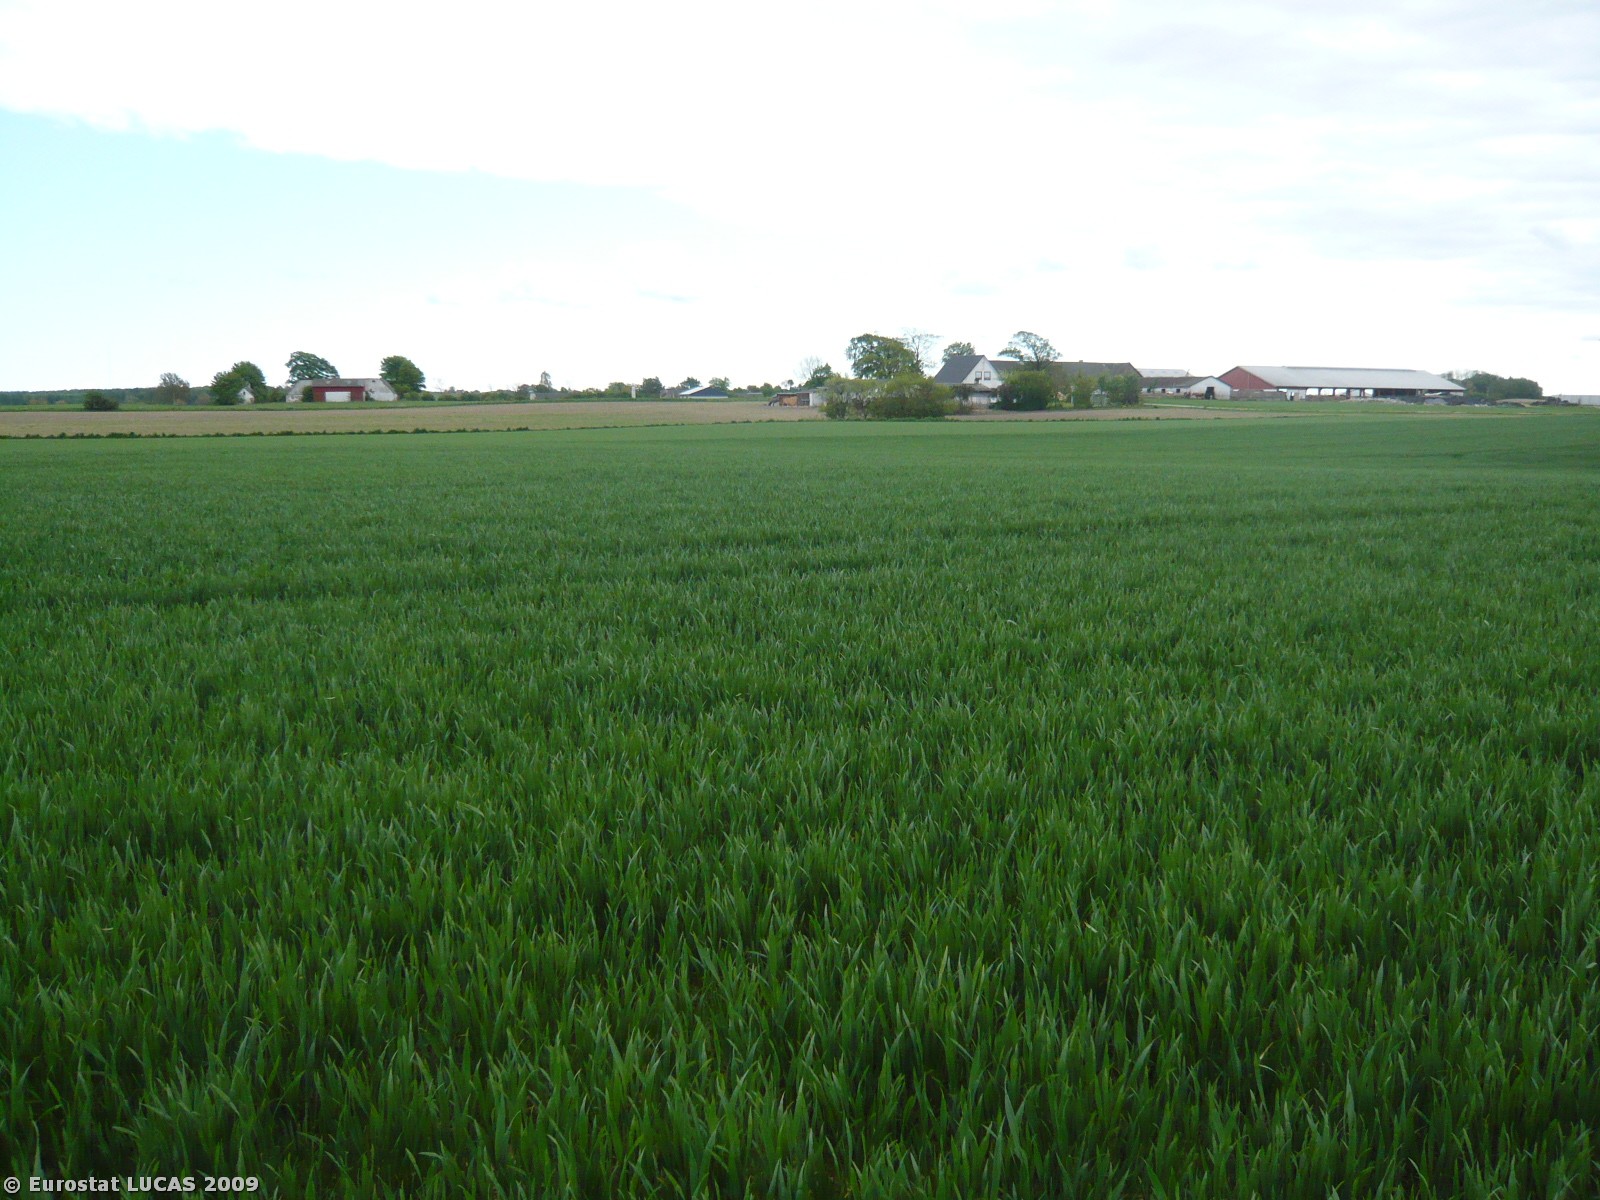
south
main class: Cropland
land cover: Common wheat
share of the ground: > 75 %
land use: Agriculture (excluding fallow land and kitchen gardens)
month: May
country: DK
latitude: 55.1125
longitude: 11.9269
